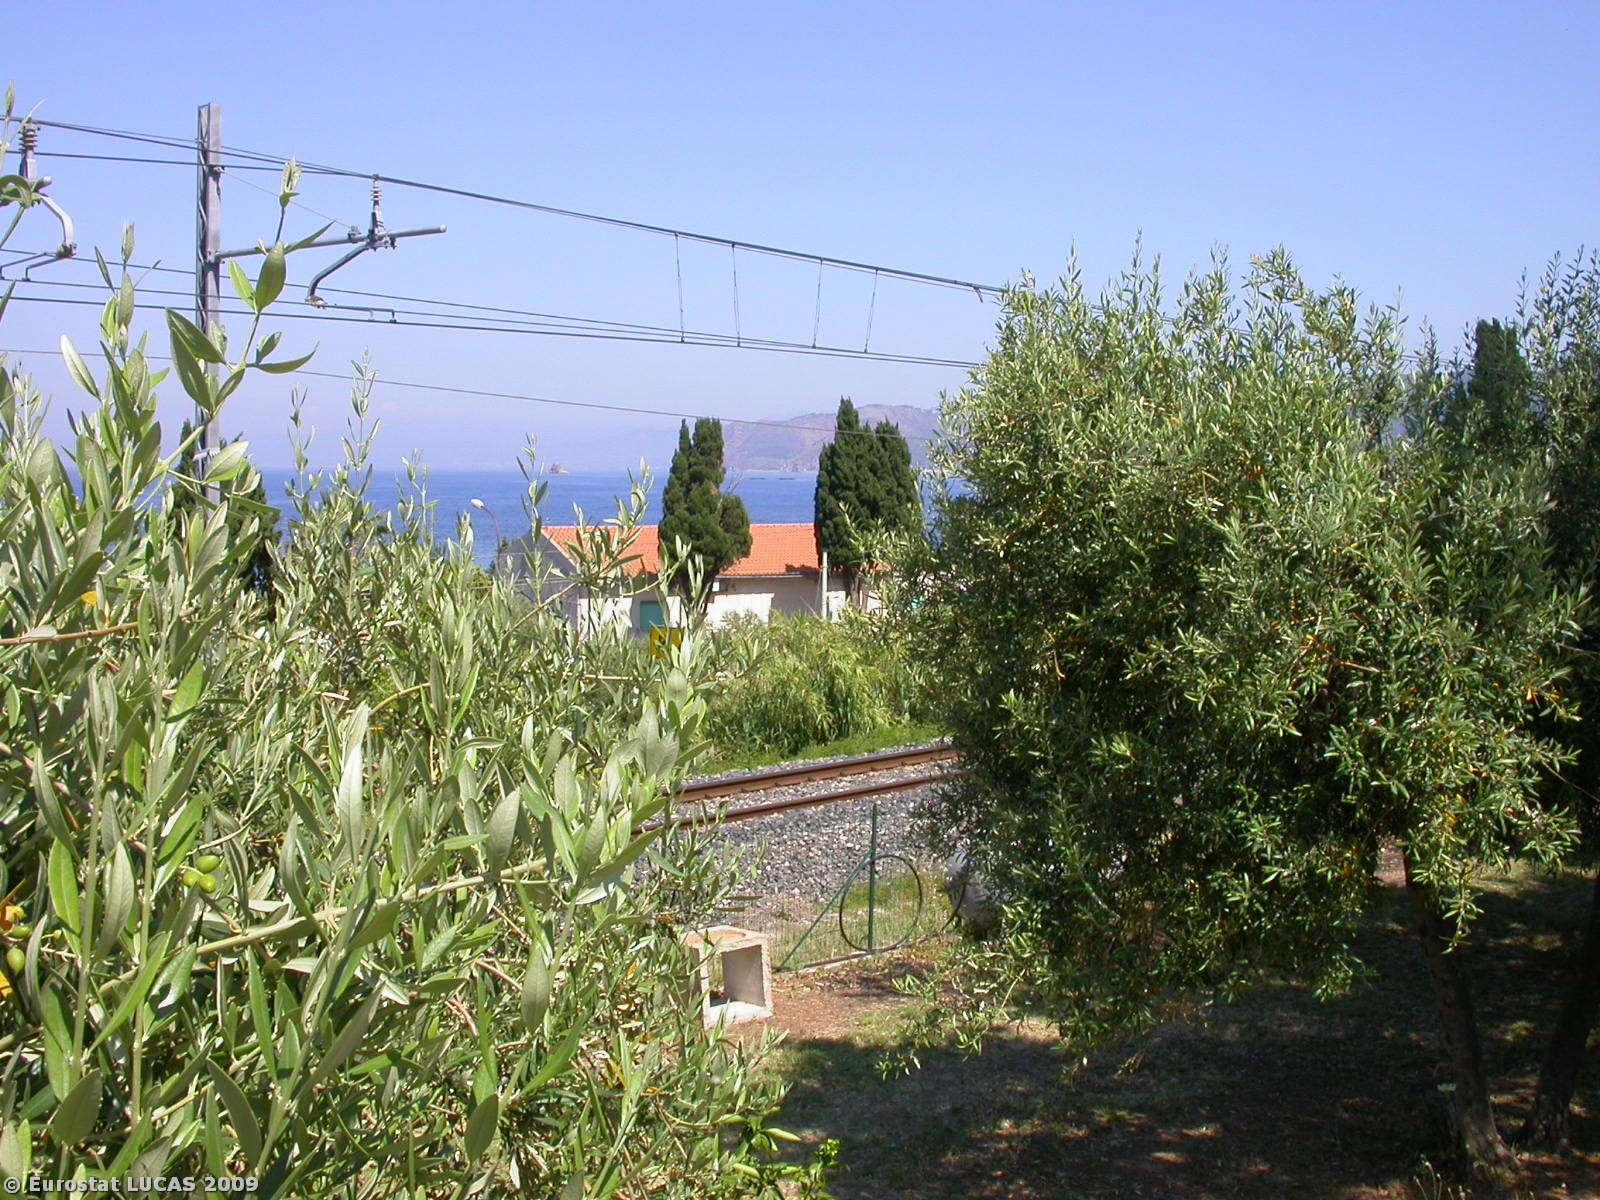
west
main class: Cropland
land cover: Olive groves
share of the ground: 50 - 75 %
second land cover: Spontaneously vegetated surfaces
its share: 25 - 50 %
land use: Agriculture (excluding fallow land and kitchen gardens)
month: June
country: IT
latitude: 38.1636
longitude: 14.9554
